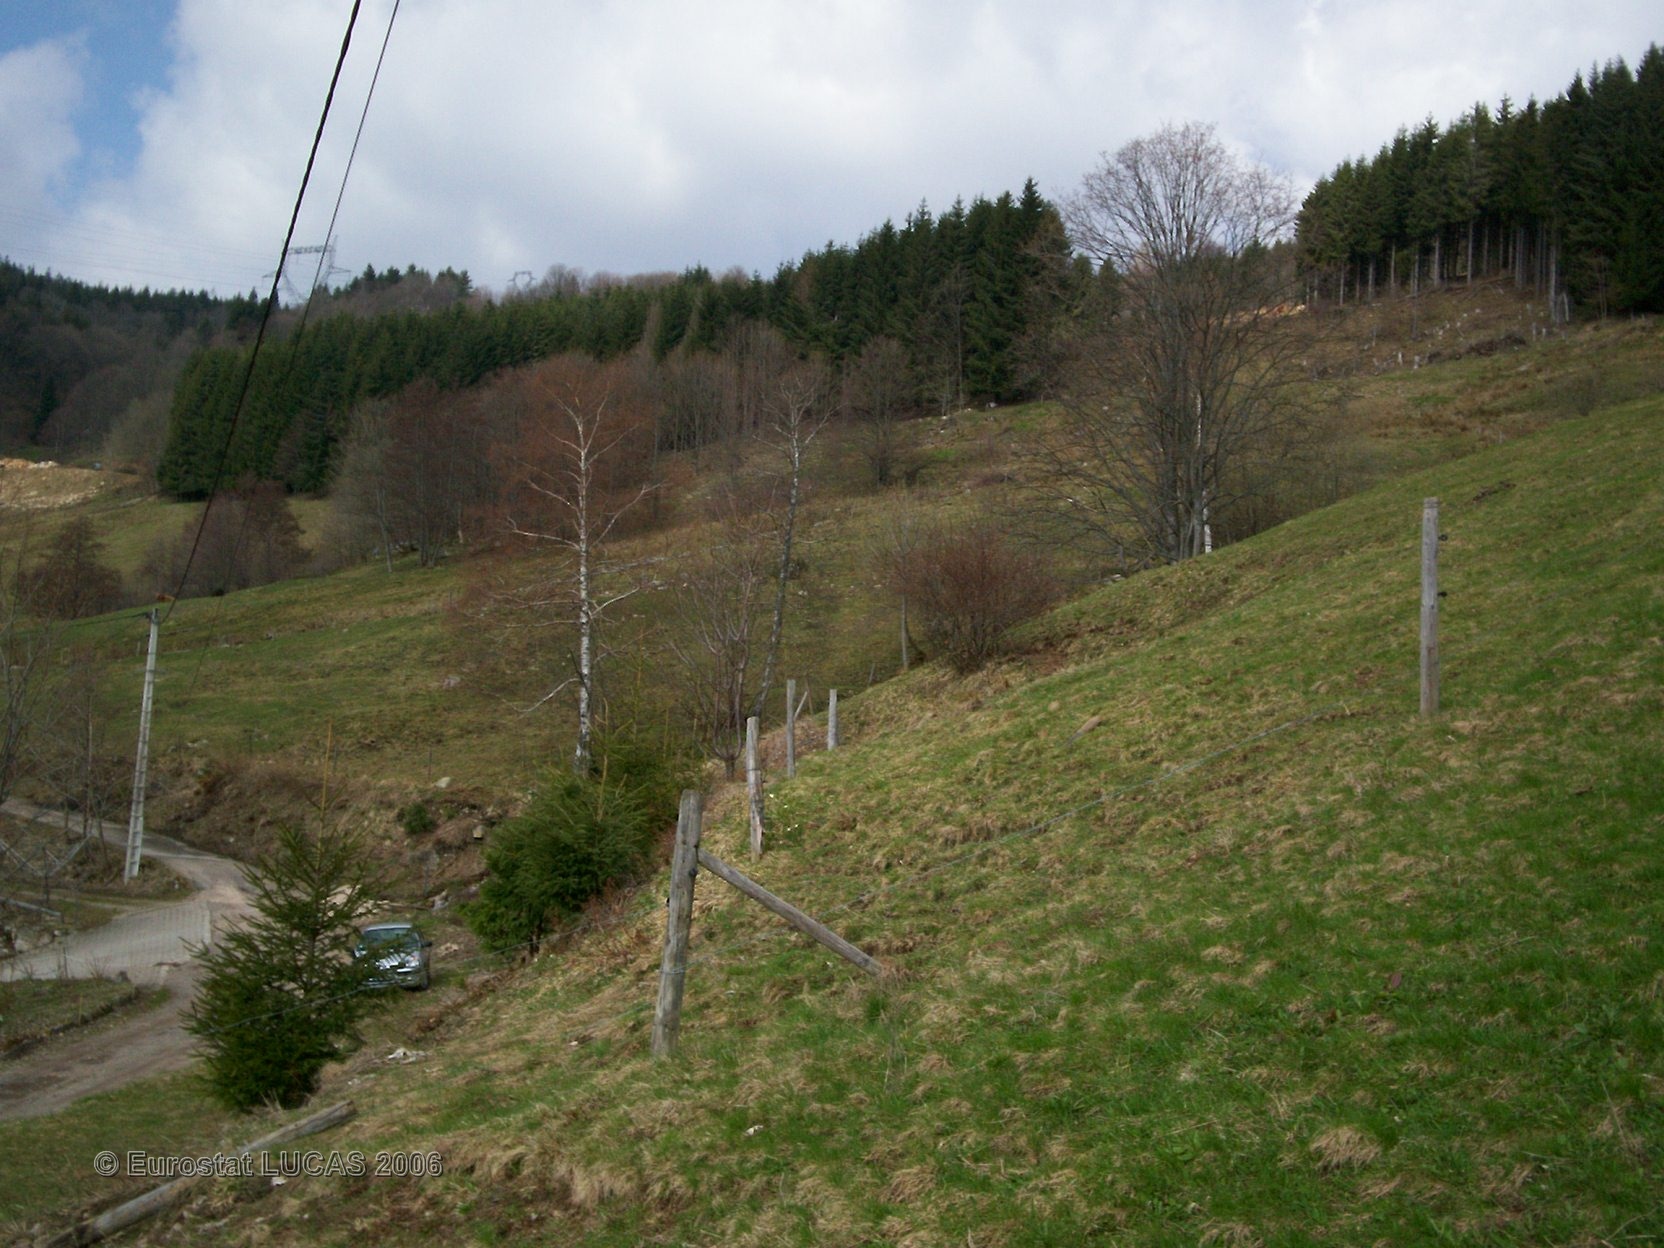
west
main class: Grassland
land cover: Grassland without tree/shrub cover
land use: Agriculture (excluding fallow land and kitchen gardens)
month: April
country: FR
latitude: 48.1317
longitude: 7.1122
